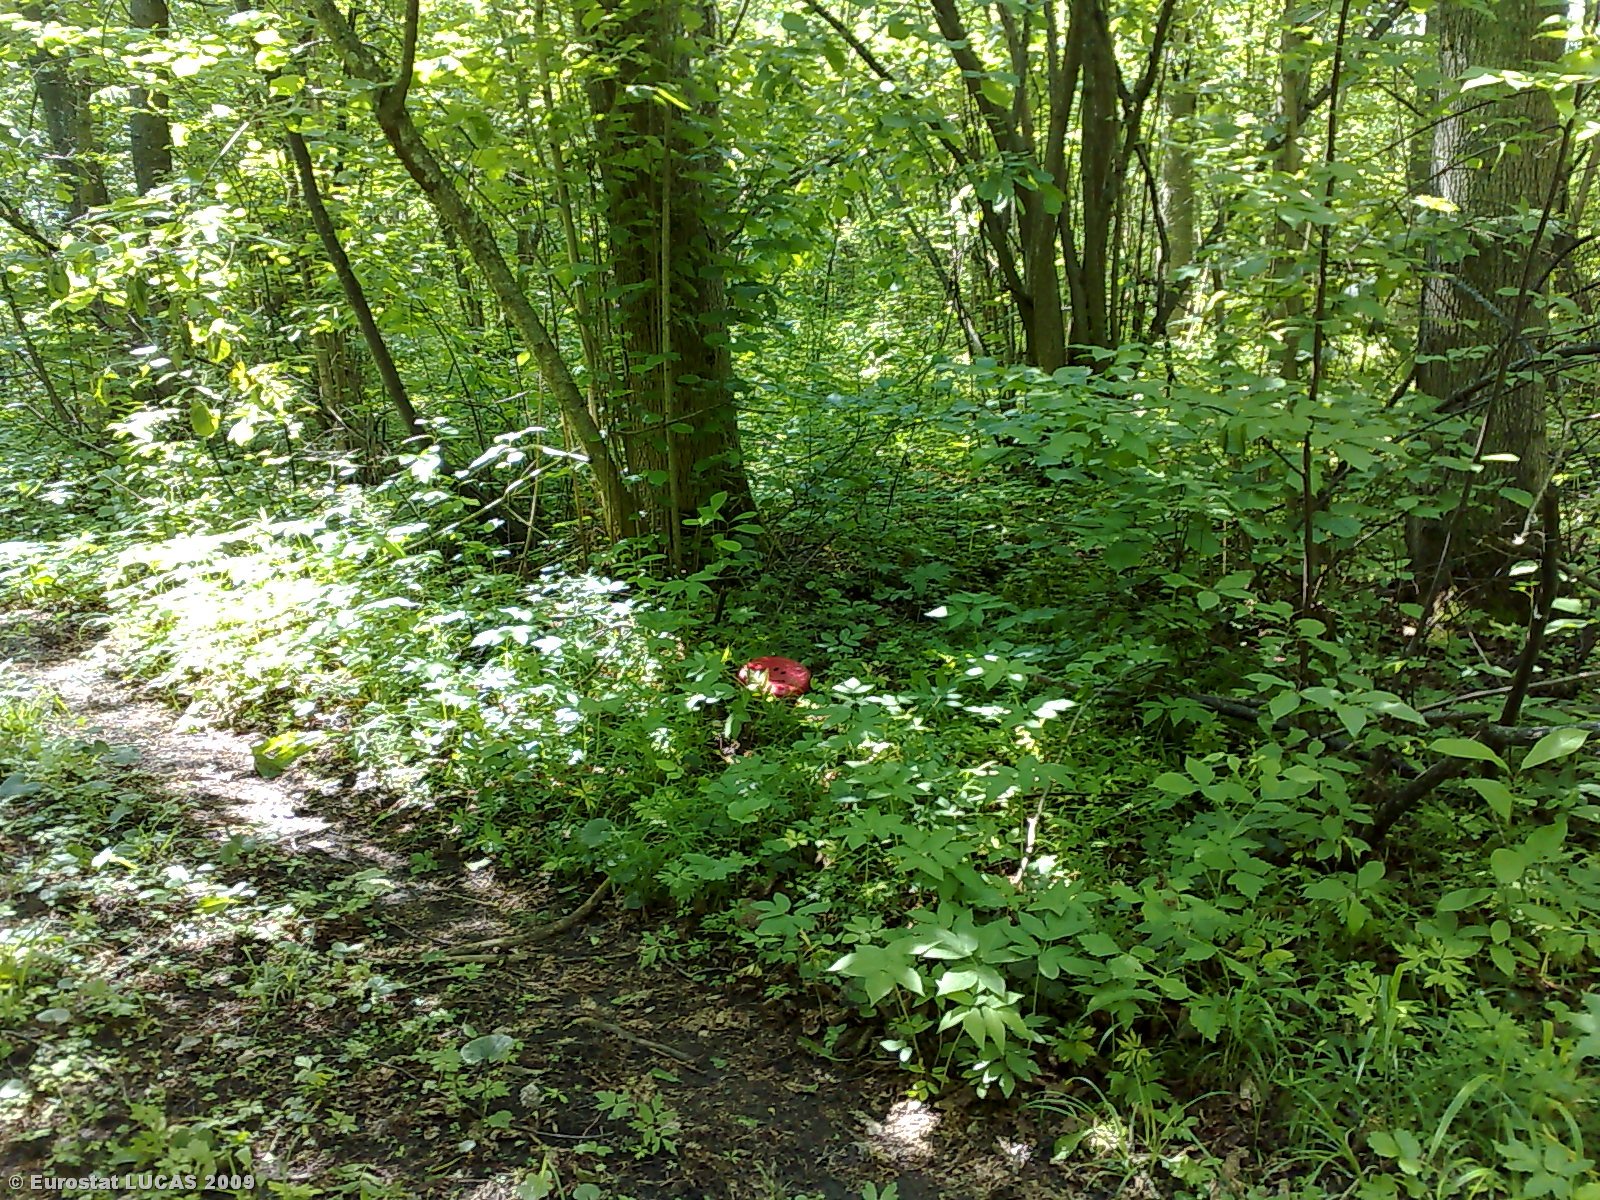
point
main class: Woodland
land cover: Broadleaved woodland
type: mesophytic deciduous forest
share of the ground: > 75 %
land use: Forestry
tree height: > 5 m
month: June
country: LT
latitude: 56.1840
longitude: 24.1551
